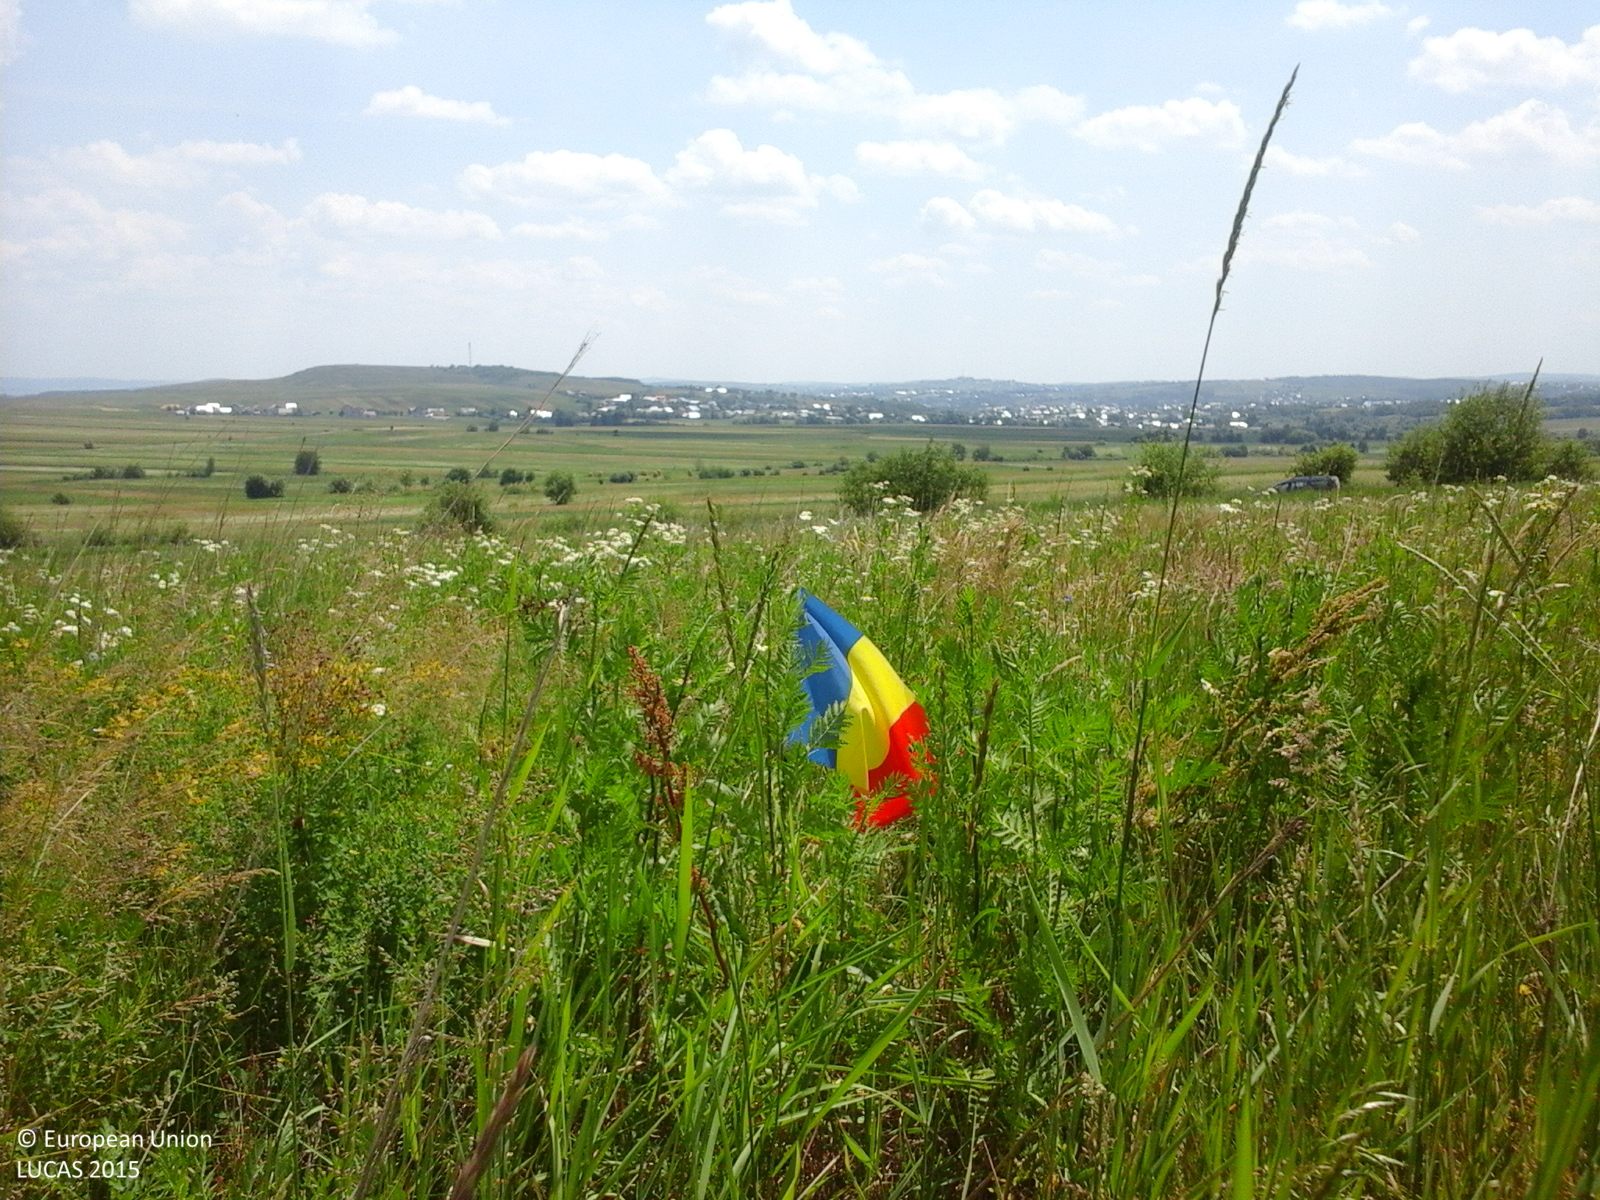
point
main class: Grassland
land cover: Grassland without tree/shrub cover
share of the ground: > 75 %
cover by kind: herbaceous plants 100 %
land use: Agriculture (excluding fallow land and kitchen gardens)
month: June
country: RO
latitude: 47.7592
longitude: 25.8829
